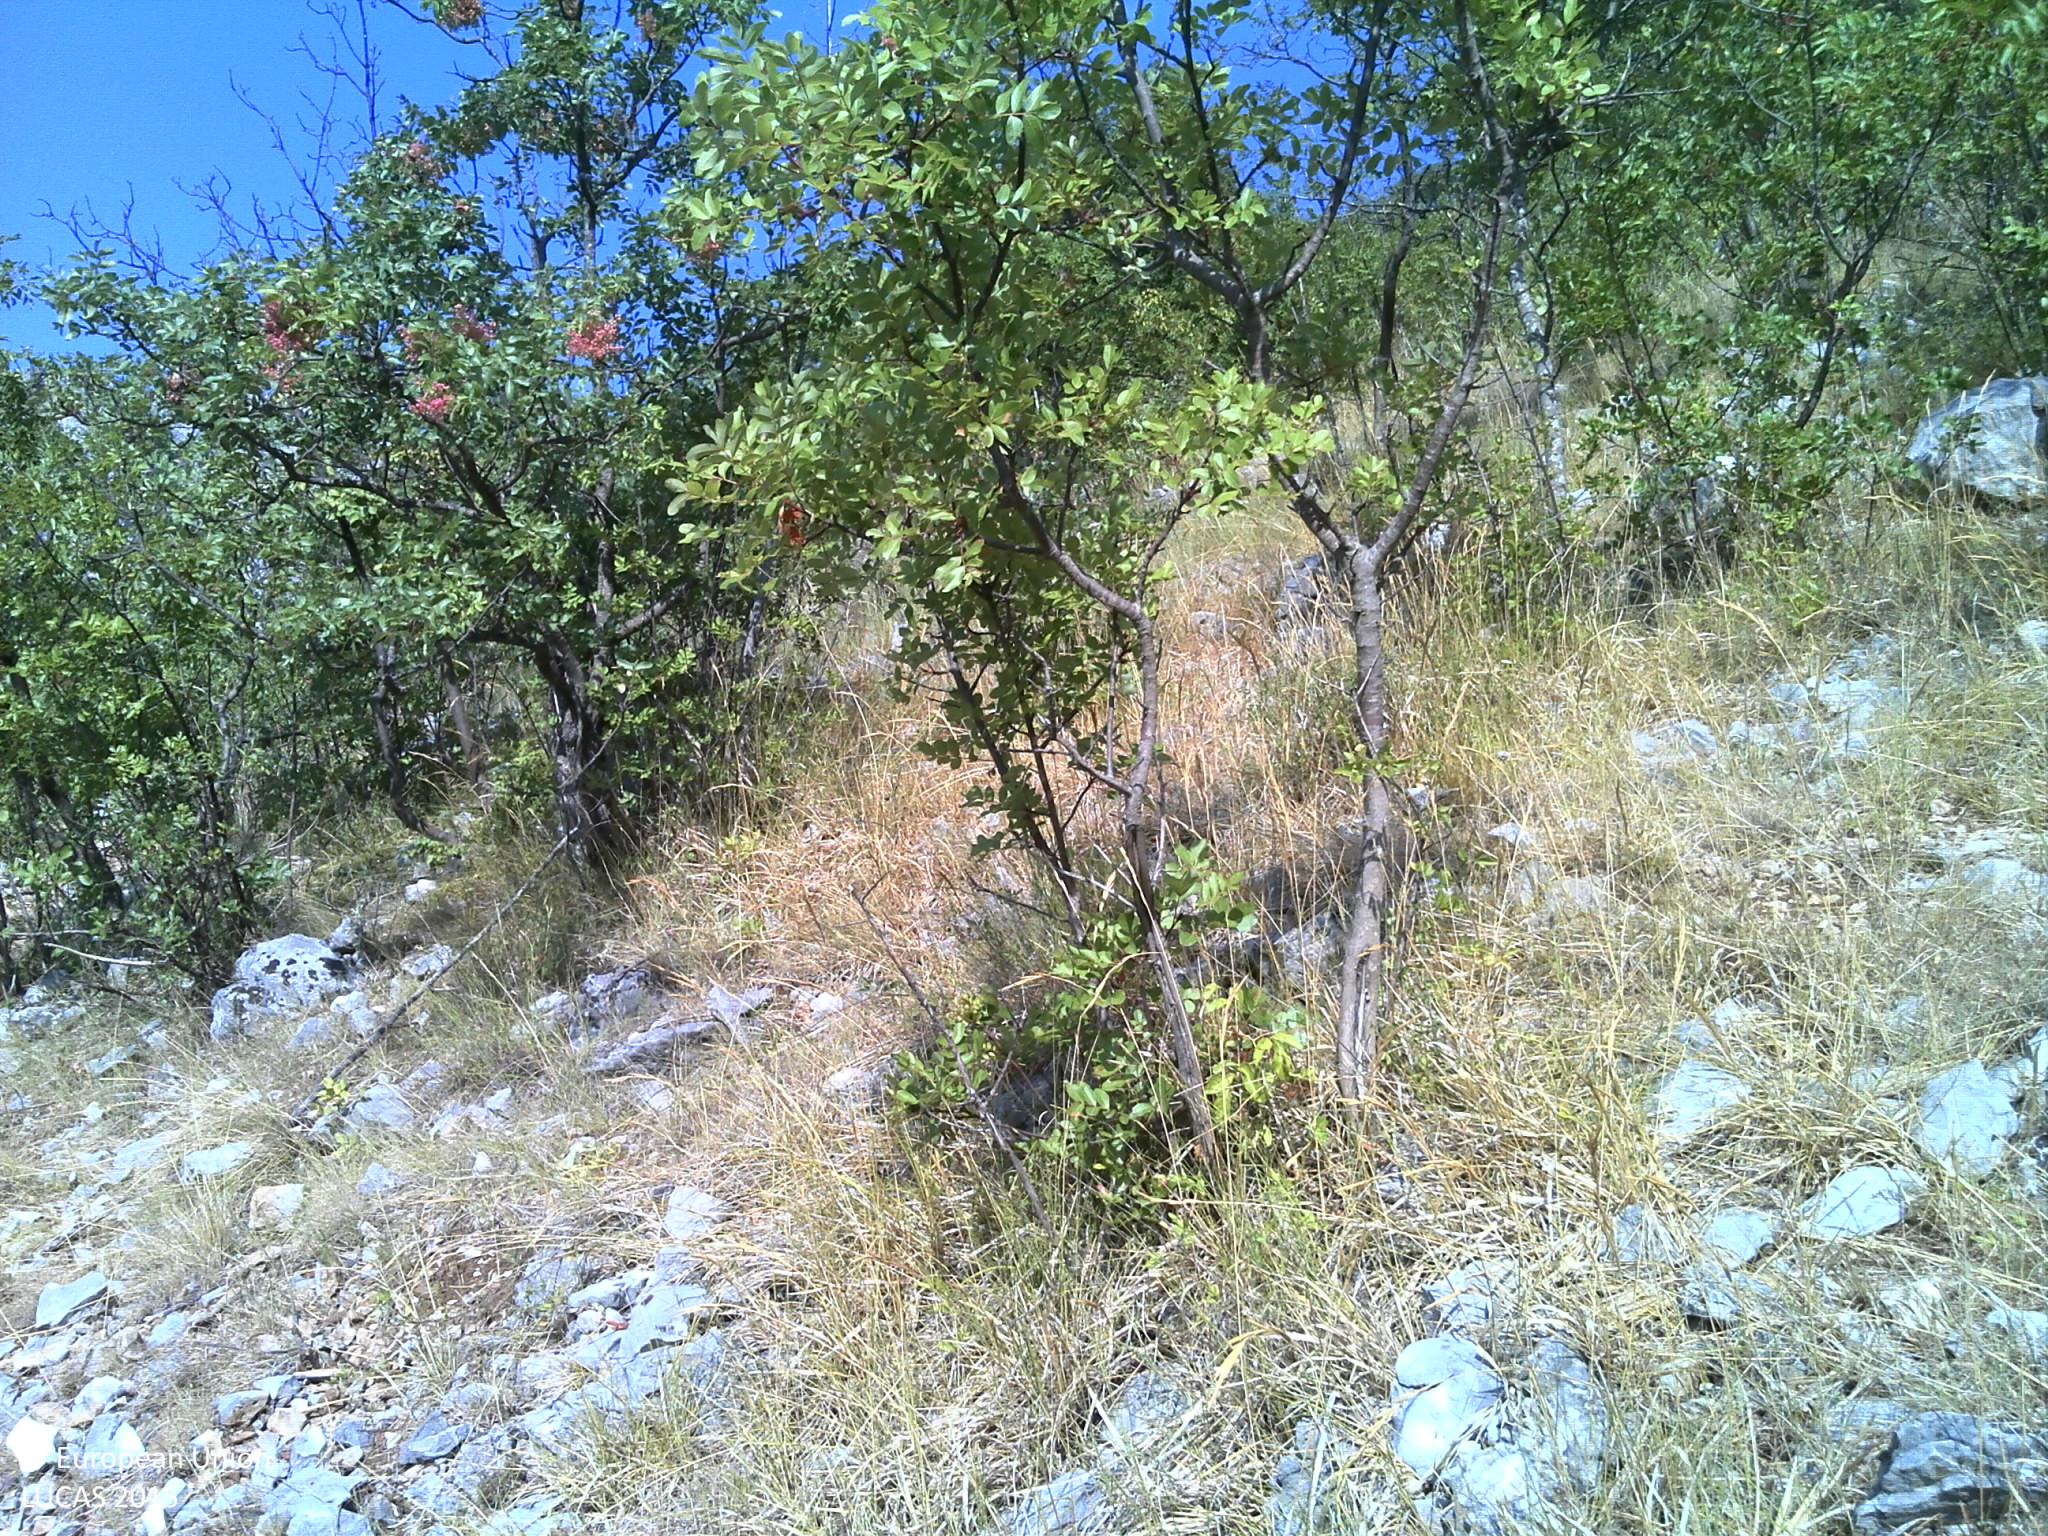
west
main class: Shrubland
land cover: Shrubland with sparse tree cover
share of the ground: 50 - 75 %
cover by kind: shrubs 60 %, consolidated bare surface 15 %, herbaceous plants 10 %, unconsolidated bare surface 10 %, broadleaved forest trees 5 %
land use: Semi-natural and natural areas not in use
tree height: < 5 m
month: July
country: HR
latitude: 43.4735
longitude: 17.1000
